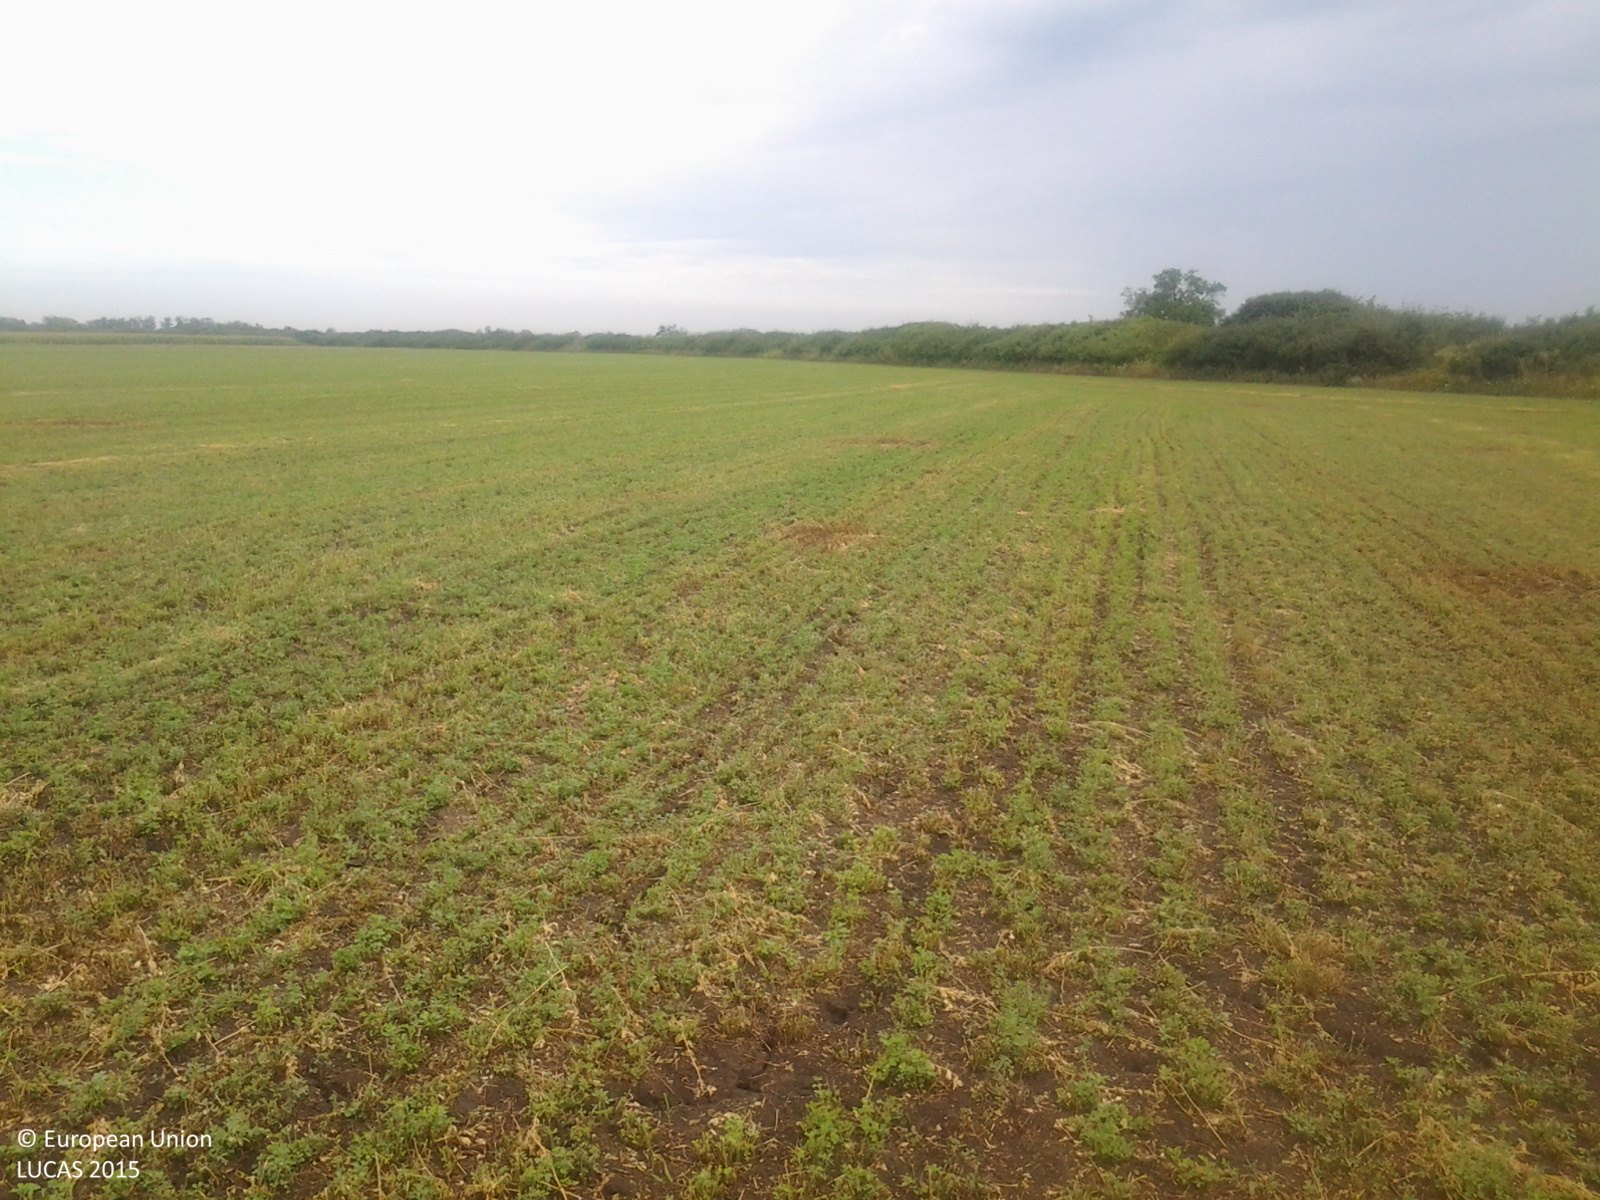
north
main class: Cropland
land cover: Lucerne
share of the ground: > 75 %
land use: Agriculture (excluding fallow land and kitchen gardens)
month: August
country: HU
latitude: 46.9202
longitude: 21.2380
